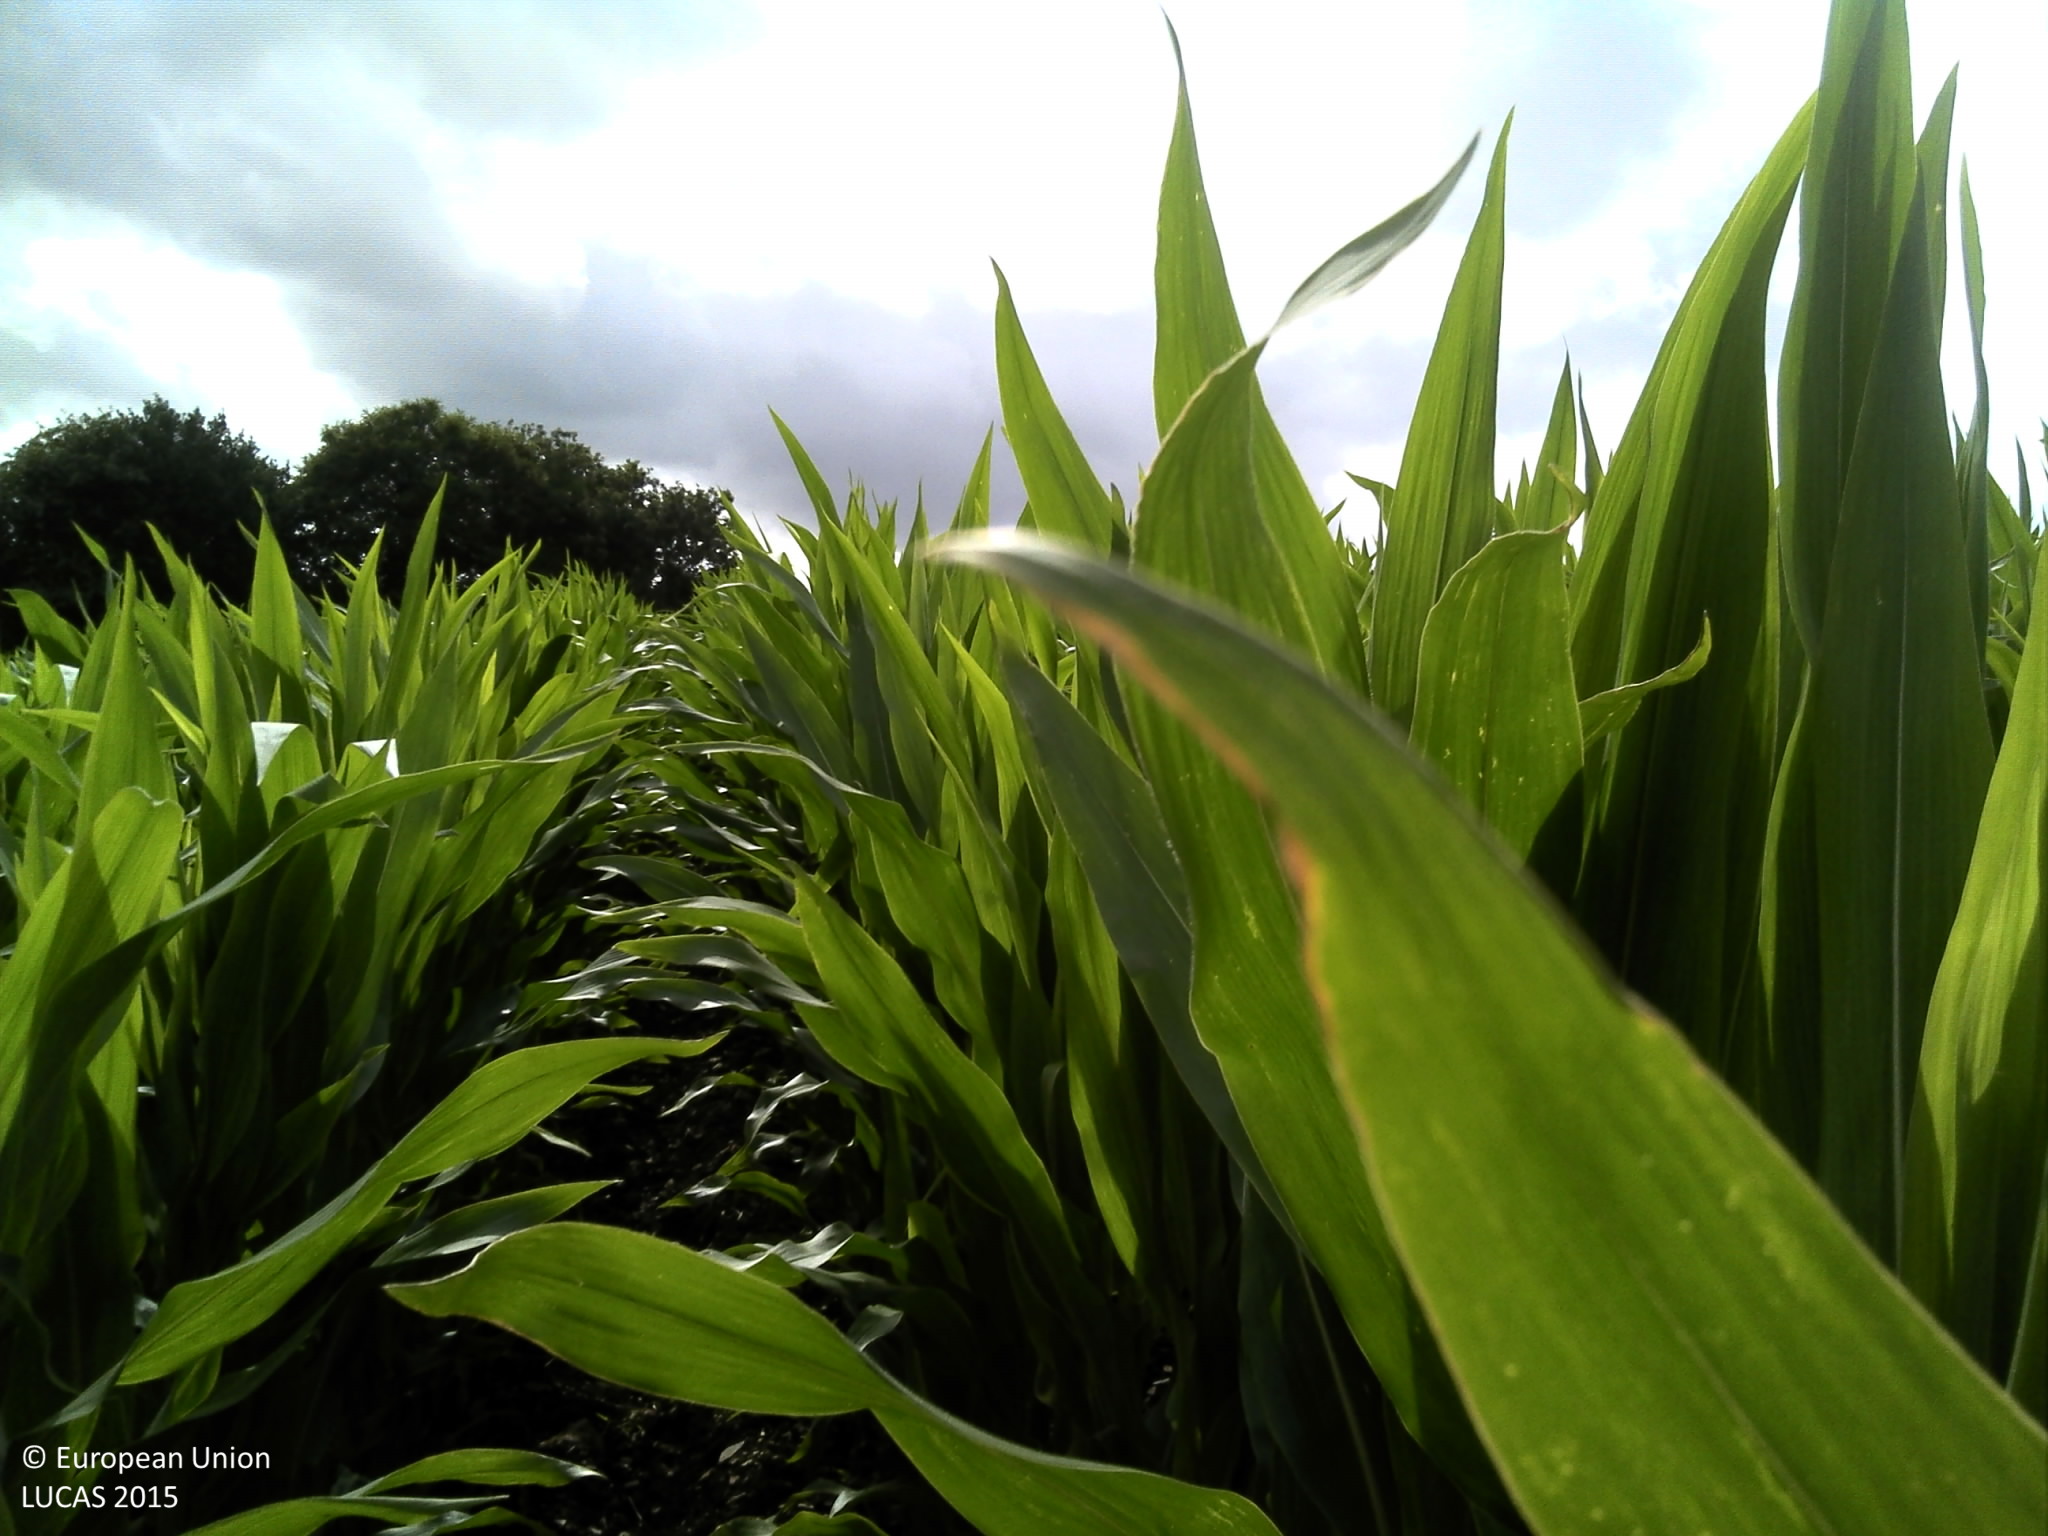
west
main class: Cropland
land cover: Maize
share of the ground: > 75 %
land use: Agriculture (excluding fallow land and kitchen gardens)
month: July
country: FR
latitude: 48.2528
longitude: -4.1653
